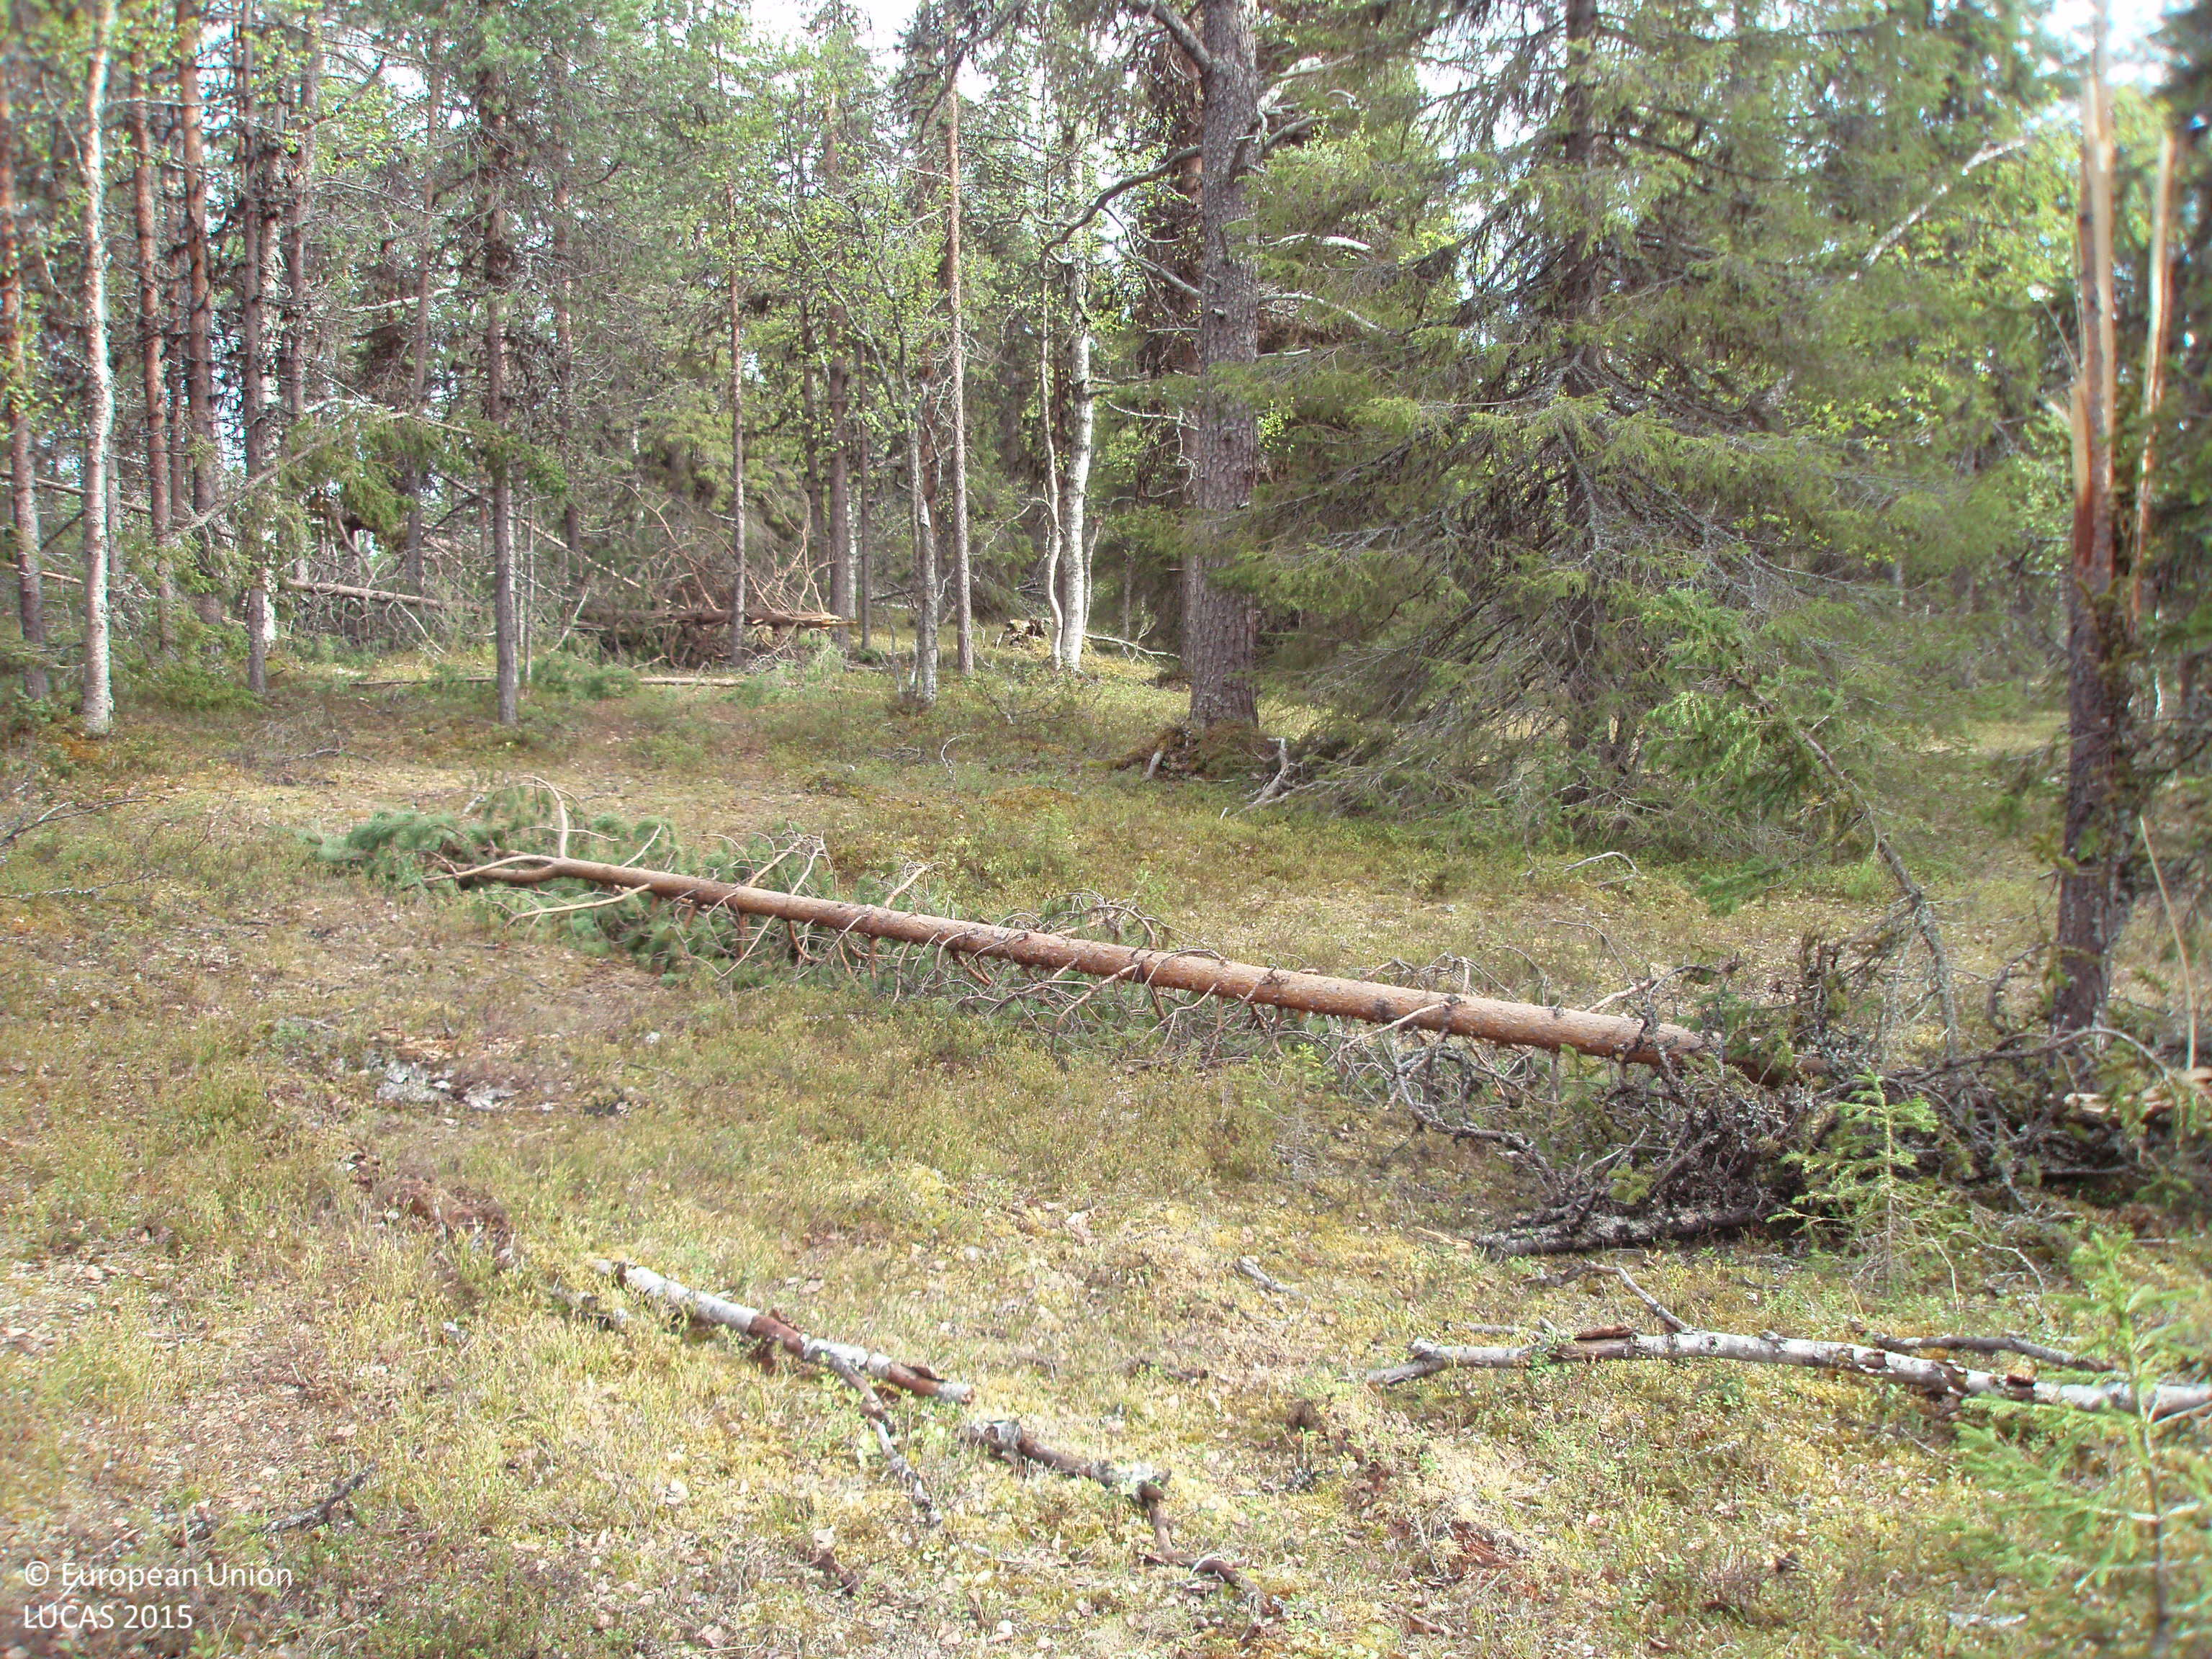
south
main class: Woodland
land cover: Other mixed woodland
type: boreal forest
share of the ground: 50 - 75 %
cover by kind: coniferous forest trees 50 %, broadleaved forest trees 20 %, shrubs 20 %, lichens and mosses 10 %
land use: Forestry
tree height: > 5 m
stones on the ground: 10 - 25 %
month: June
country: FI
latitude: 68.2769
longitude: 26.9936
